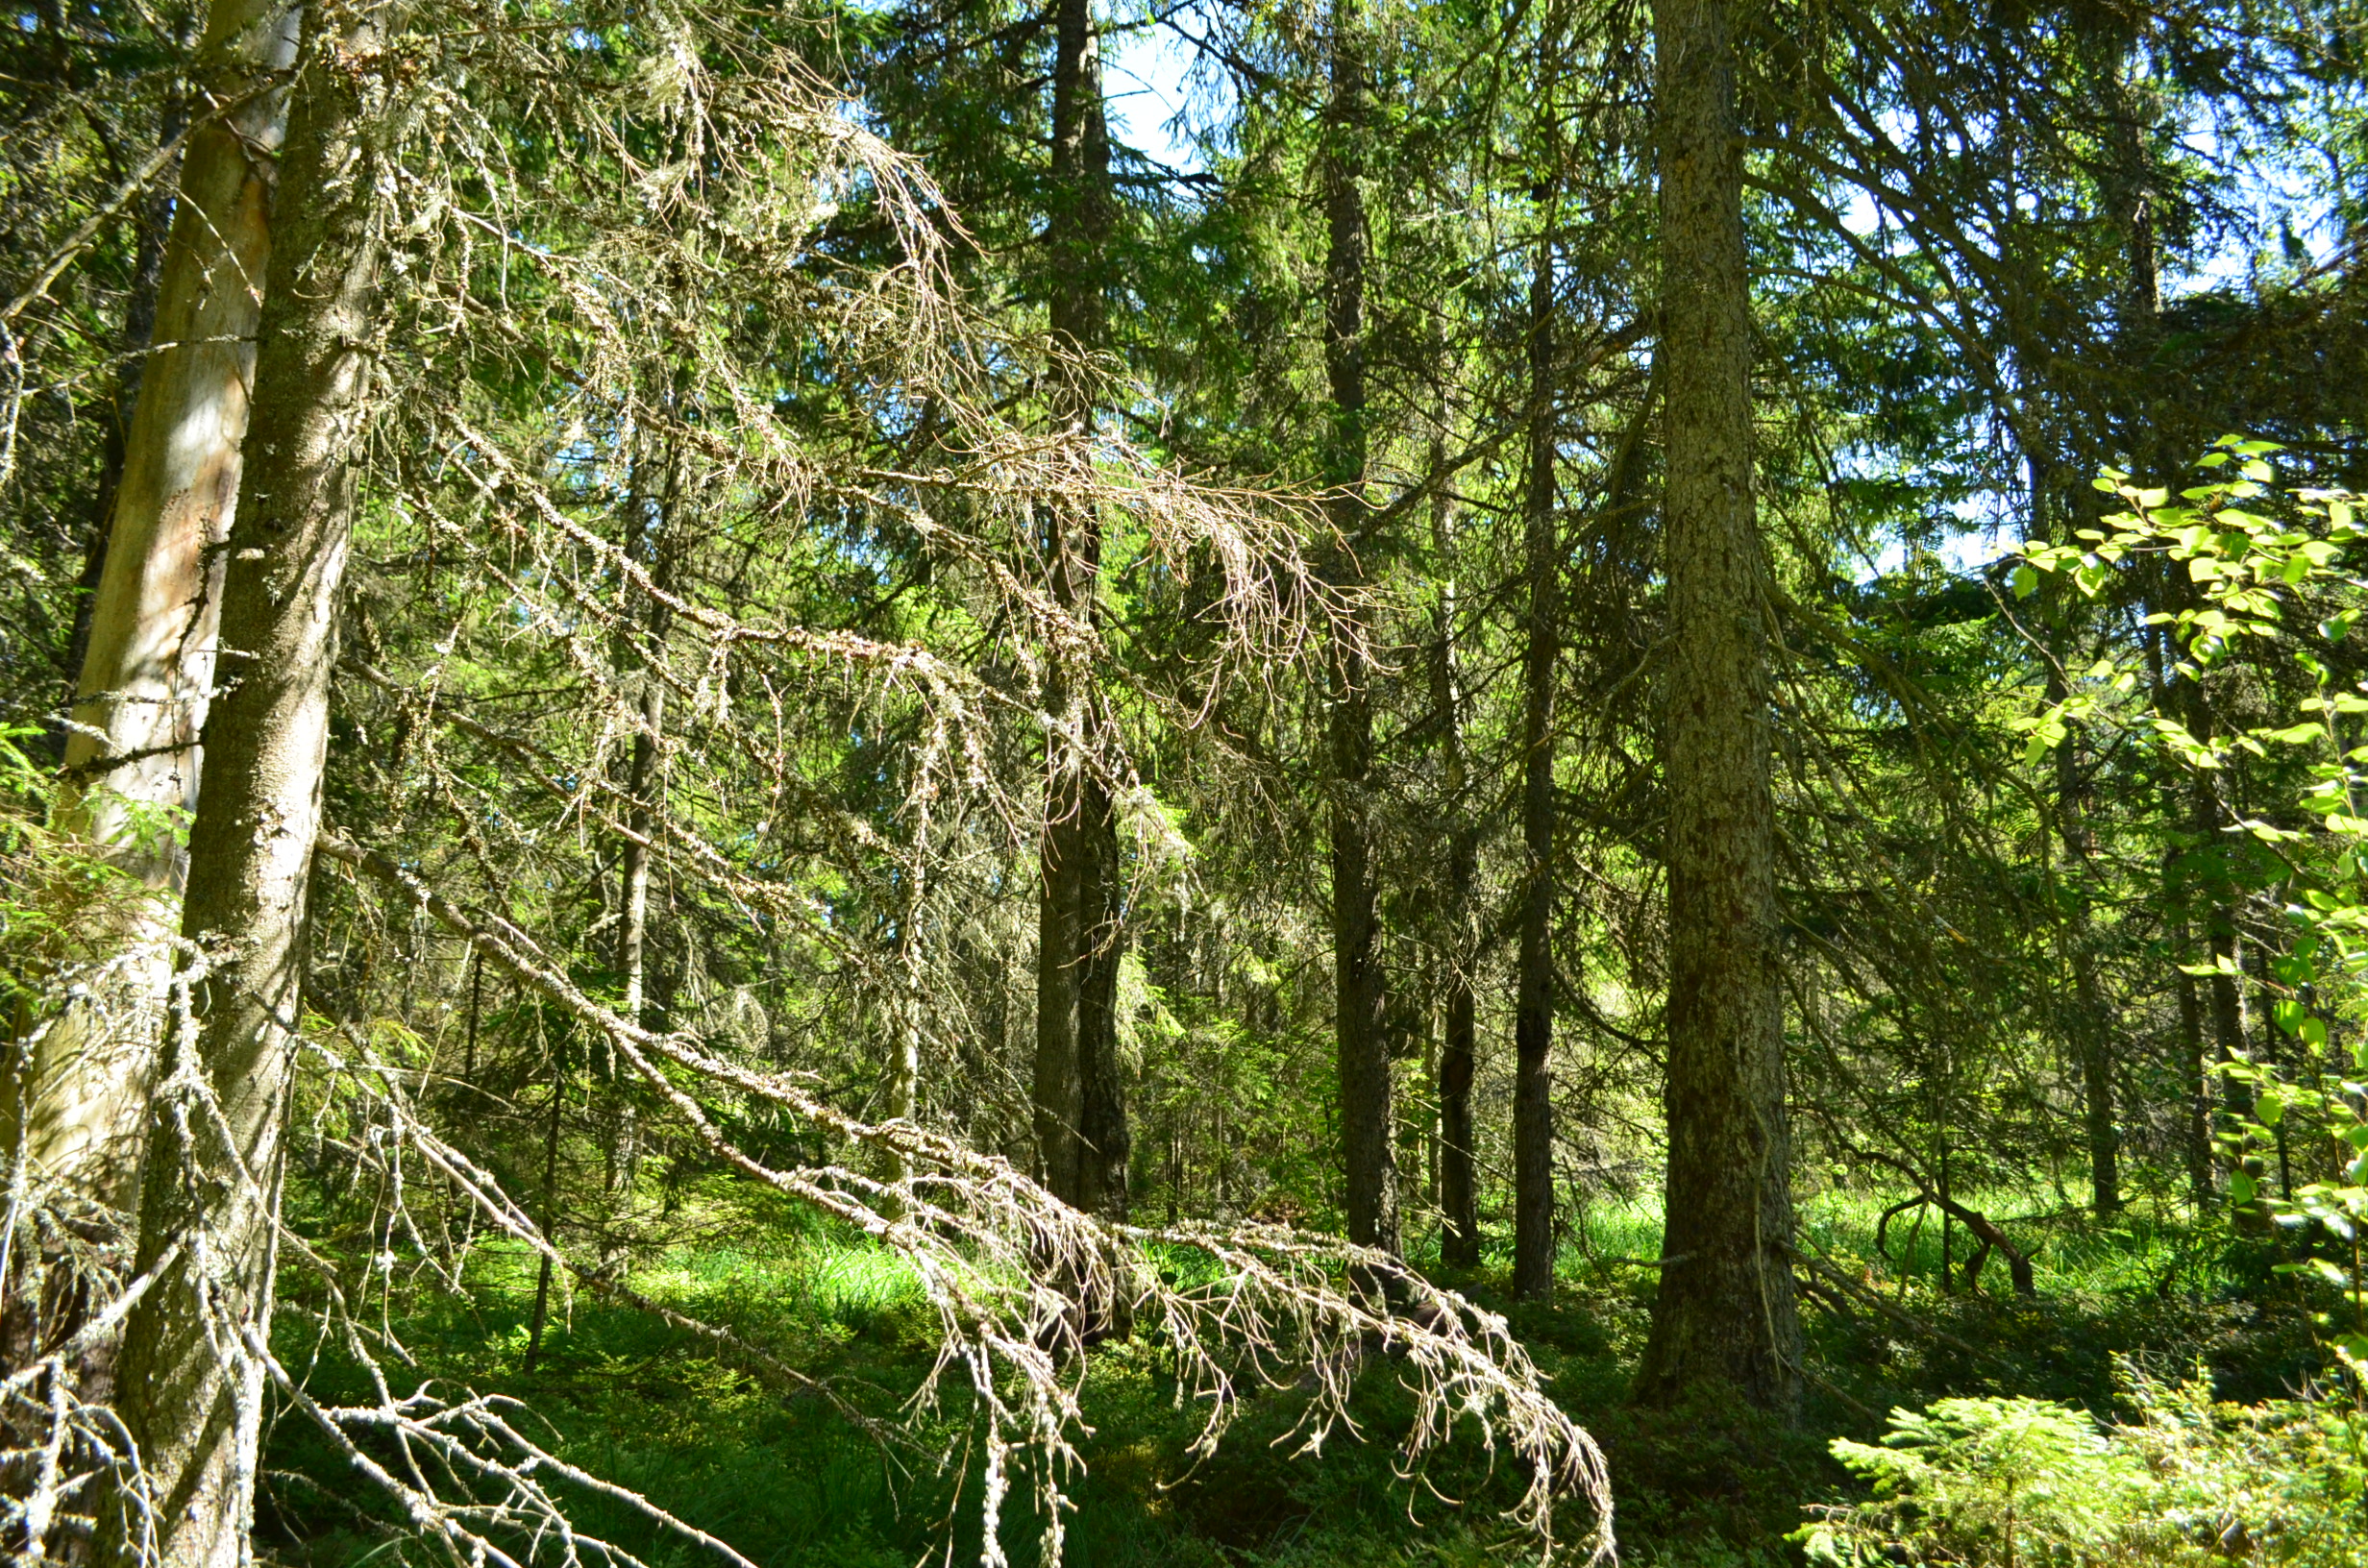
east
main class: Woodland
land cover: Other coniferous woodland
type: hemiboreal forest and nemoral coniferous forest and mixed broadleaved-coniferous forest
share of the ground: 50 - 75 %
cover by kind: coniferous forest trees 70 %, shrubs 10 %, herbaceous plants 10 %, broadleaved forest trees 5 %, lichens and mosses 5 %
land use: Forestry
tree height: > 5 m
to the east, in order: Other coniferous woodland
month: August
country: LV
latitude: 57.5606
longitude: 22.3013
